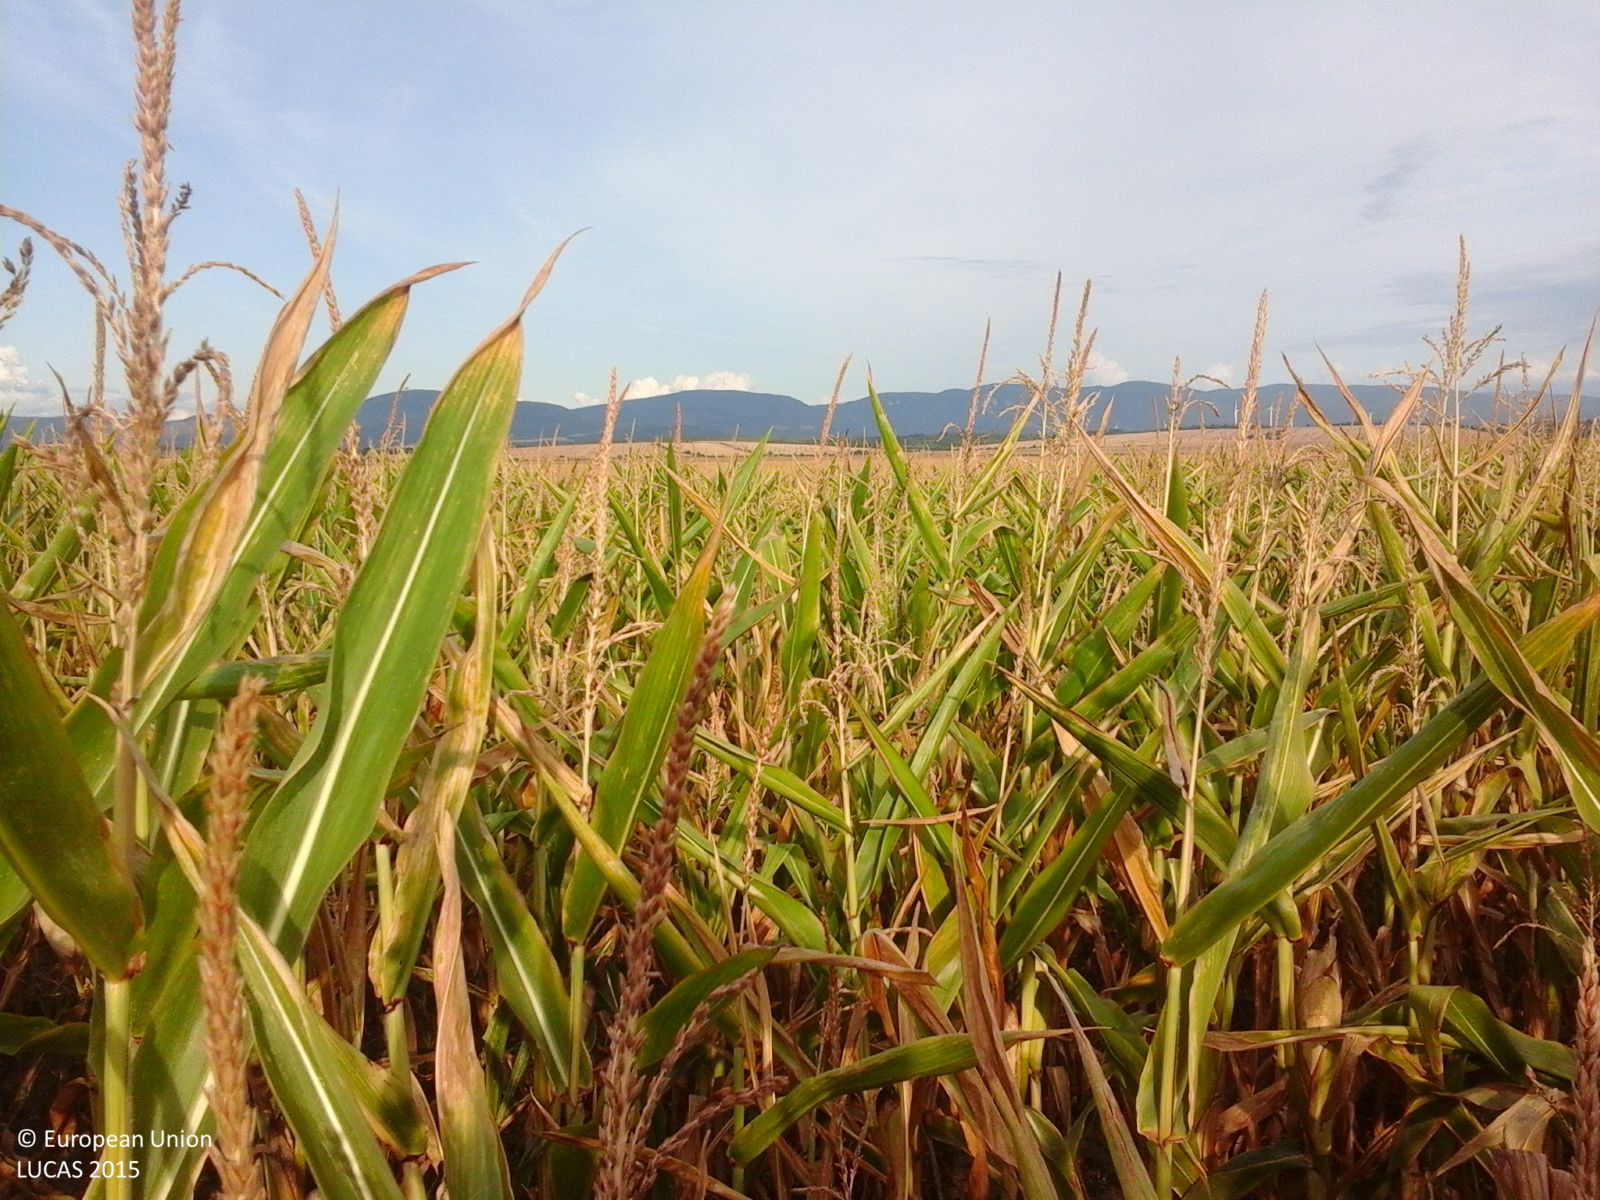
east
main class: Cropland
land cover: Maize
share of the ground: > 75 %
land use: Agriculture (excluding fallow land and kitchen gardens)
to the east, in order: Maize; Grass margins; Tracks; Maize
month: August
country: RO
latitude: 45.0478
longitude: 21.5714
